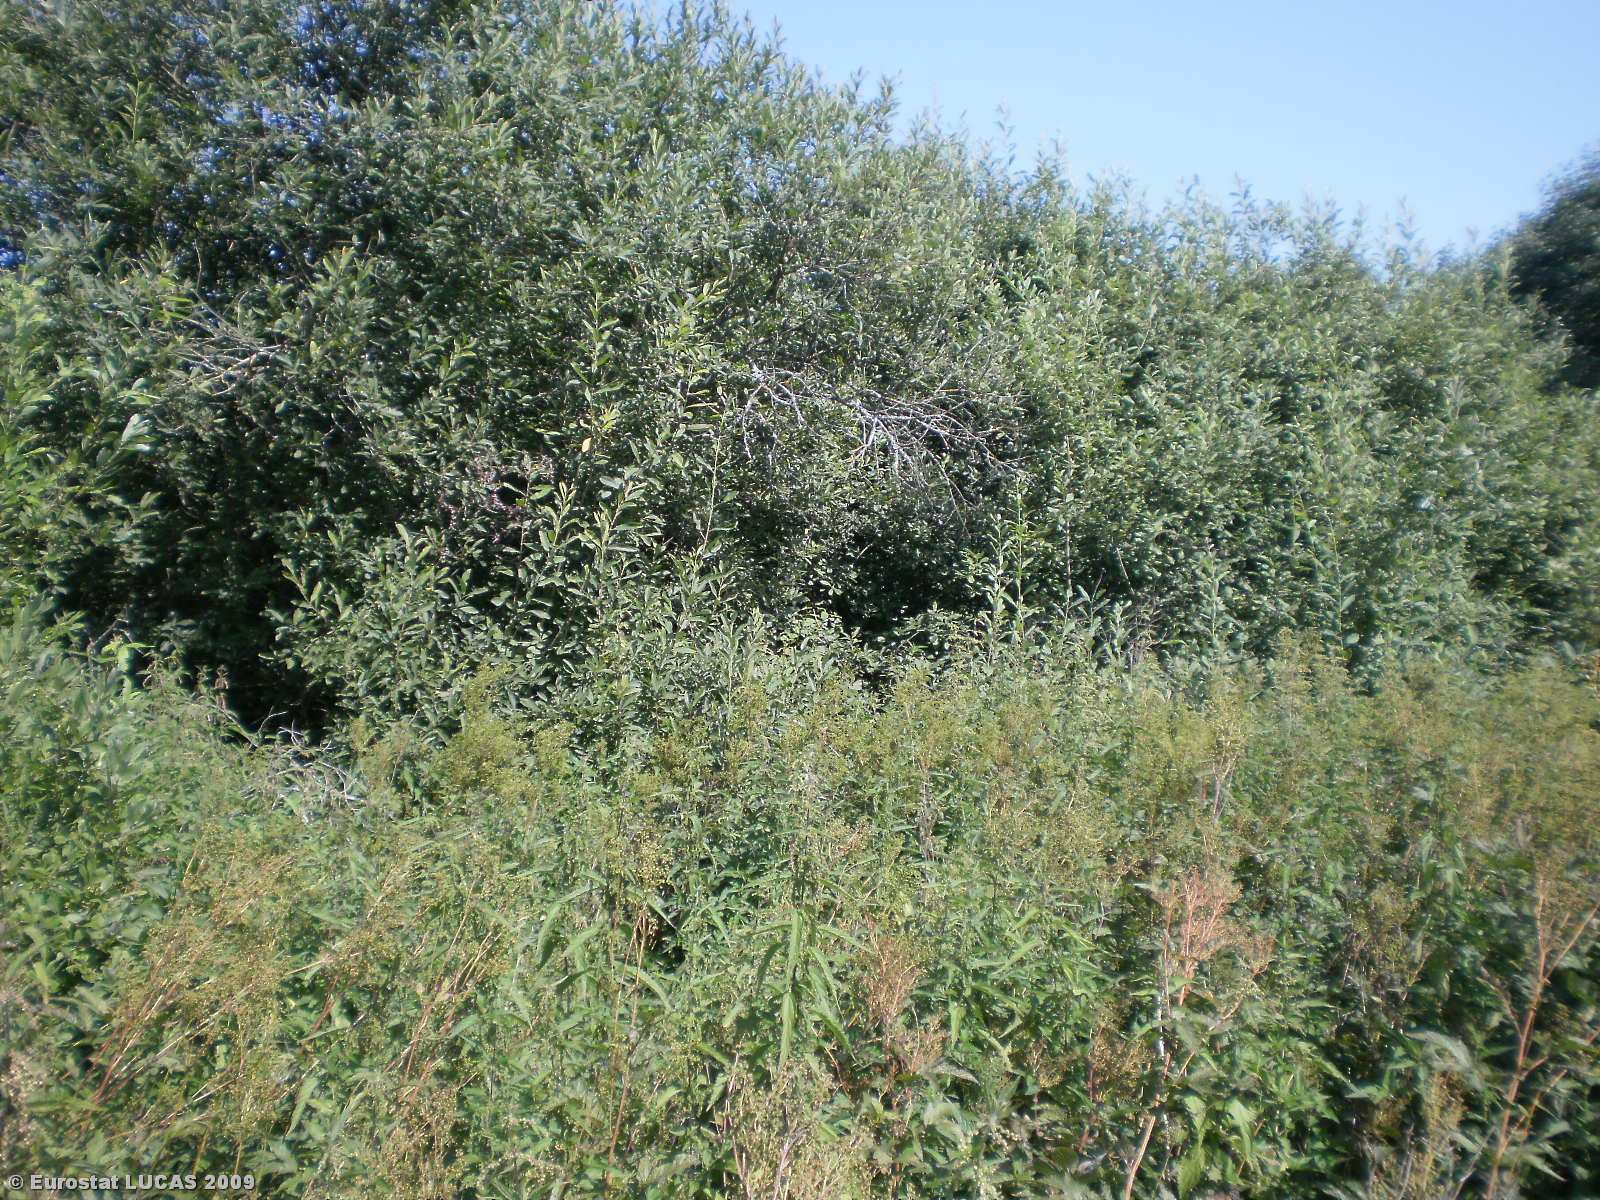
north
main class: Shrubland
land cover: Shrubland with sparse tree cover
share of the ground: > 75 %
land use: Unused
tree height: < 5 m
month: August
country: LT
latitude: 55.5500
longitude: 24.7356
